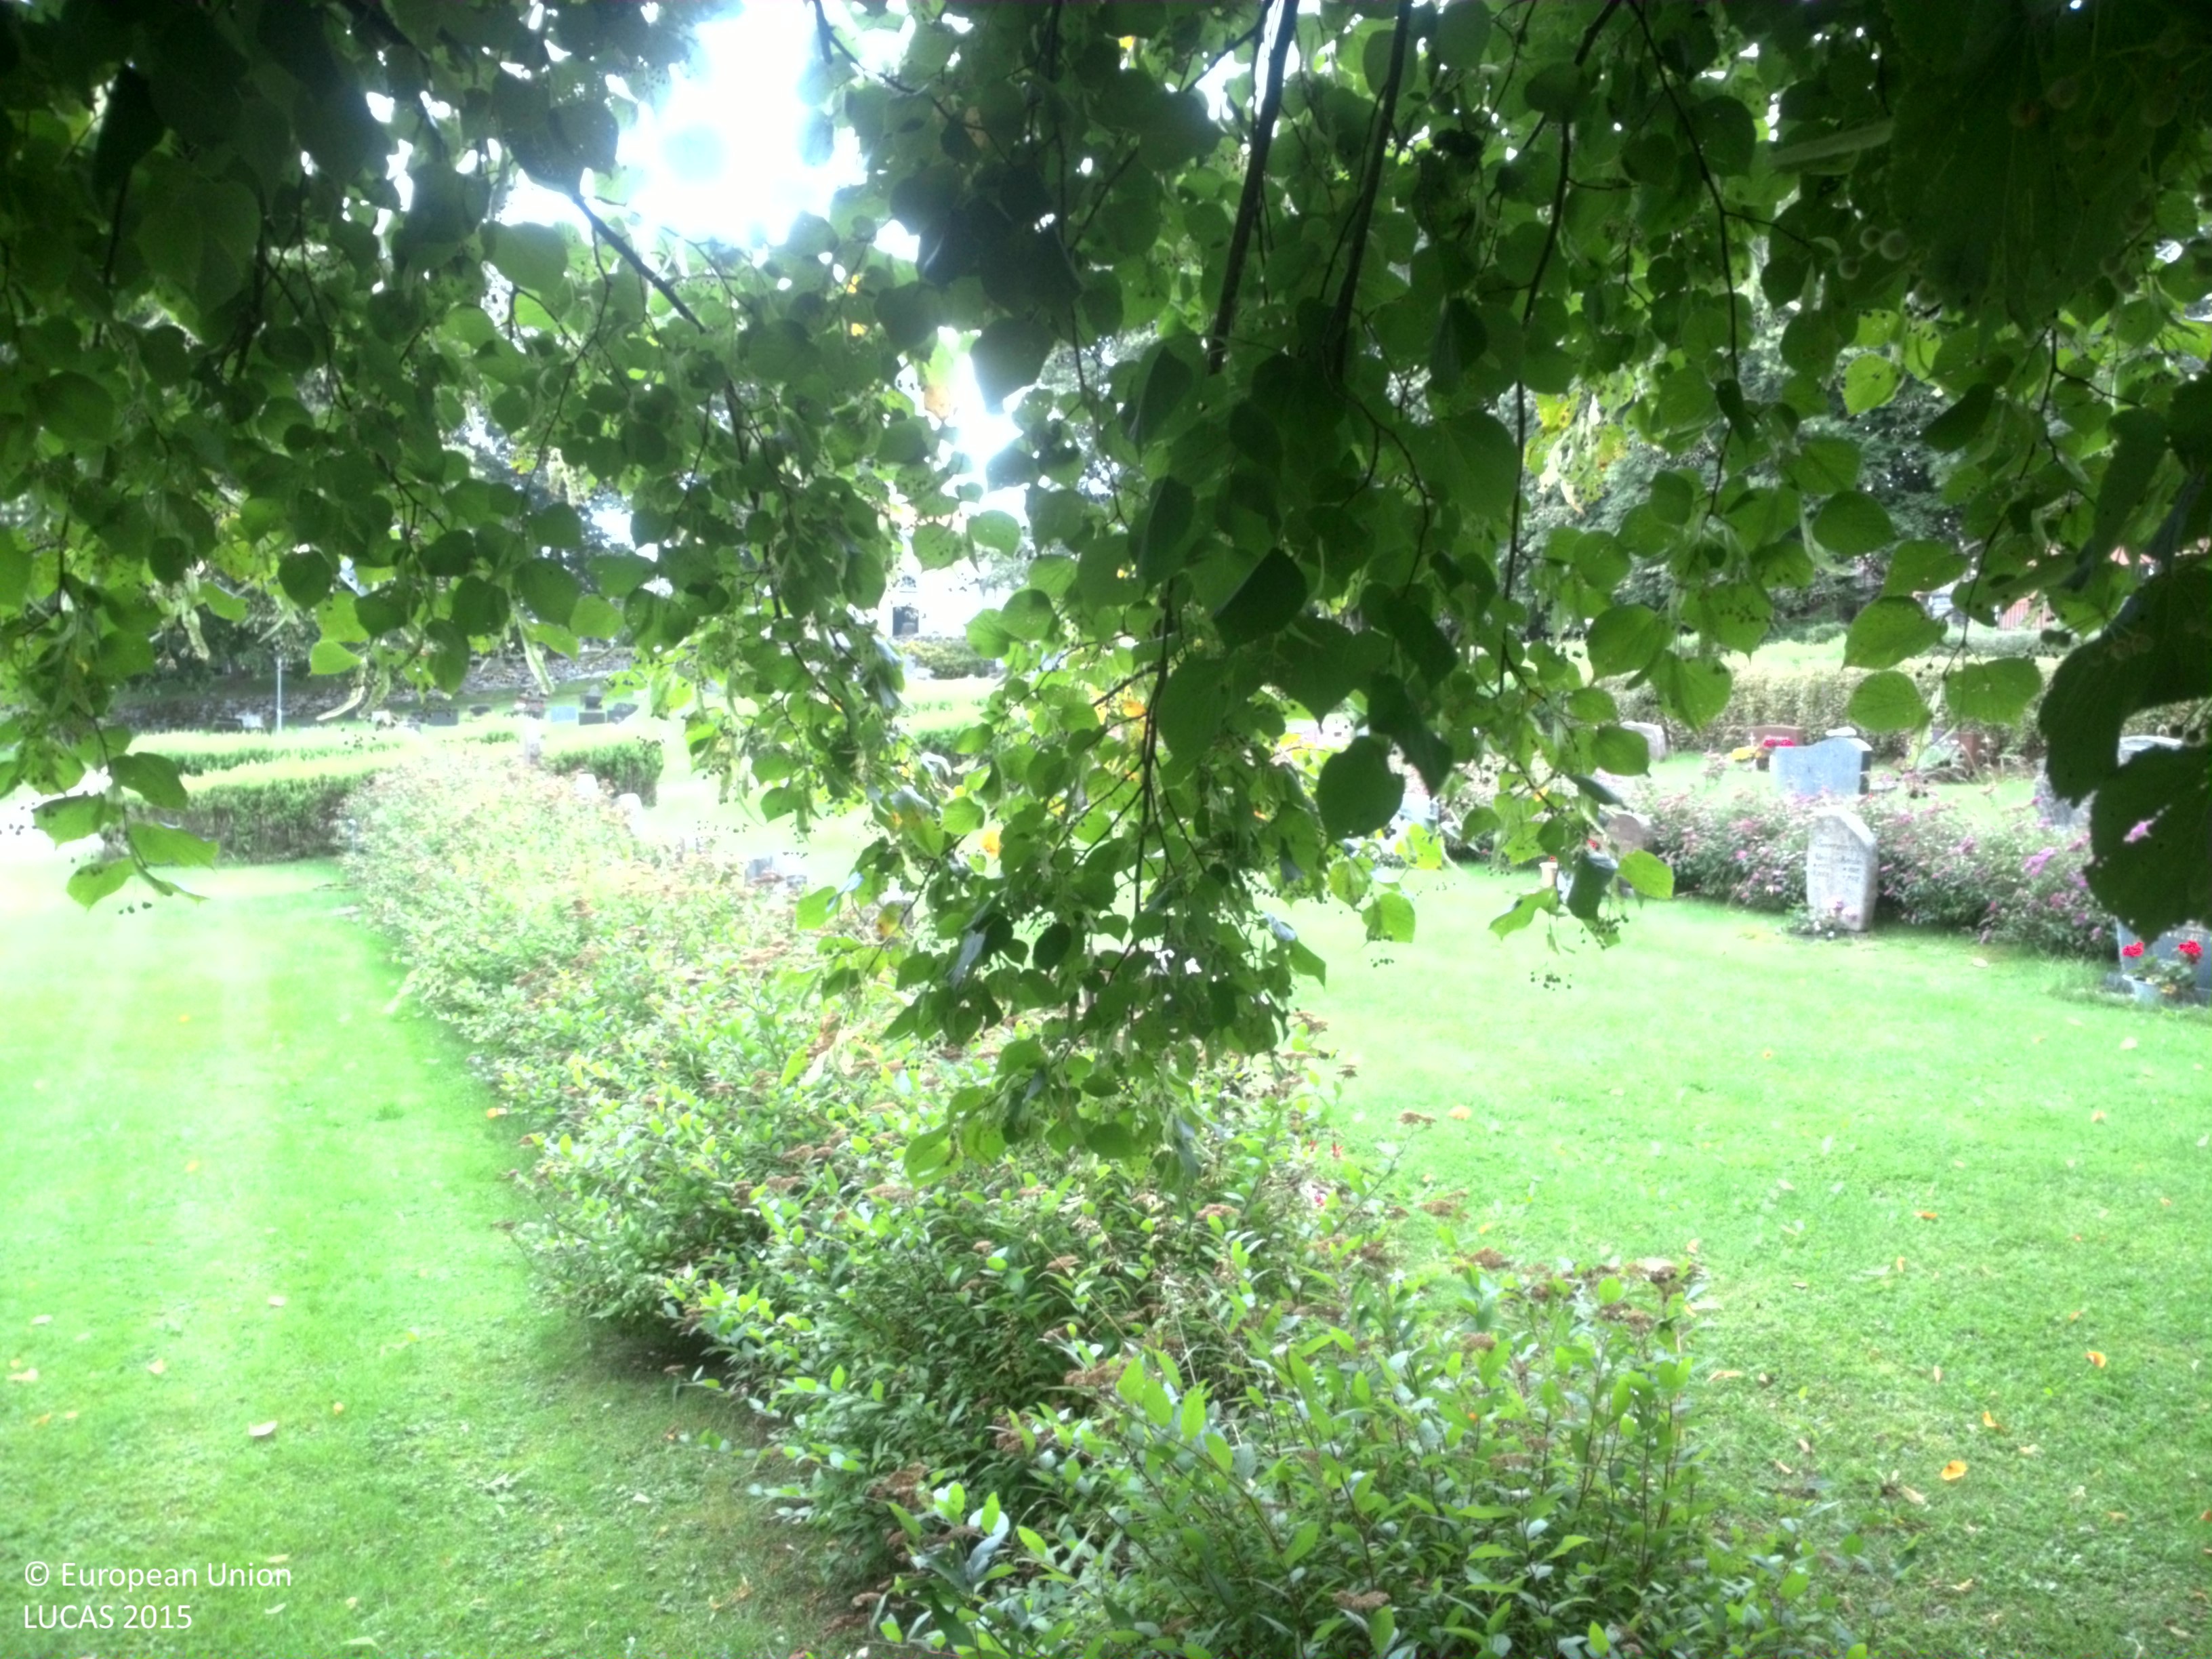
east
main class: Grassland
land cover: Grassland without tree/shrub cover
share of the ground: > 75 %
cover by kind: herbaceous plants 100 %
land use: Community services
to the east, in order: Lines of trees; Grassland without tree/shrub cover; Artificial constructions in urban areas
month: August
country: SE
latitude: 57.8375
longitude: 13.2795
